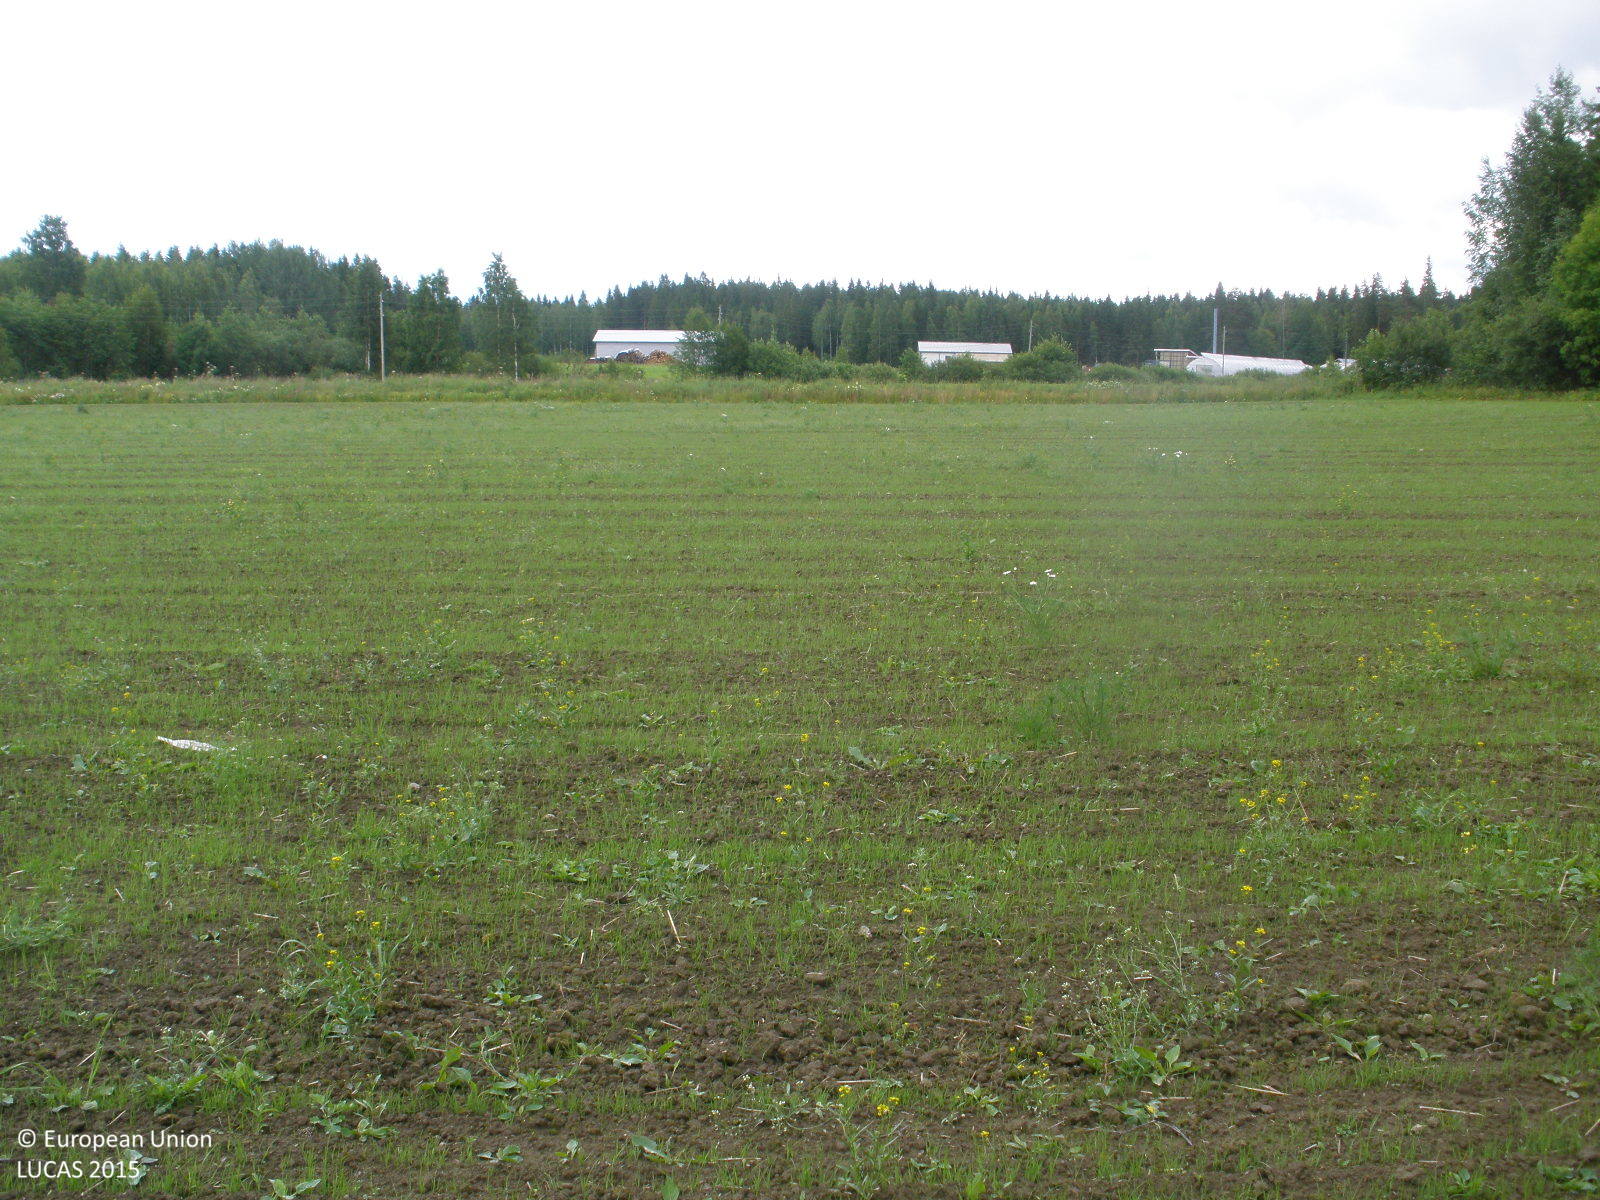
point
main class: Cropland
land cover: Oats
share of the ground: < 10 %
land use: Agriculture (excluding fallow land and kitchen gardens)
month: July
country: FI
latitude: 61.4888
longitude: 24.6181
